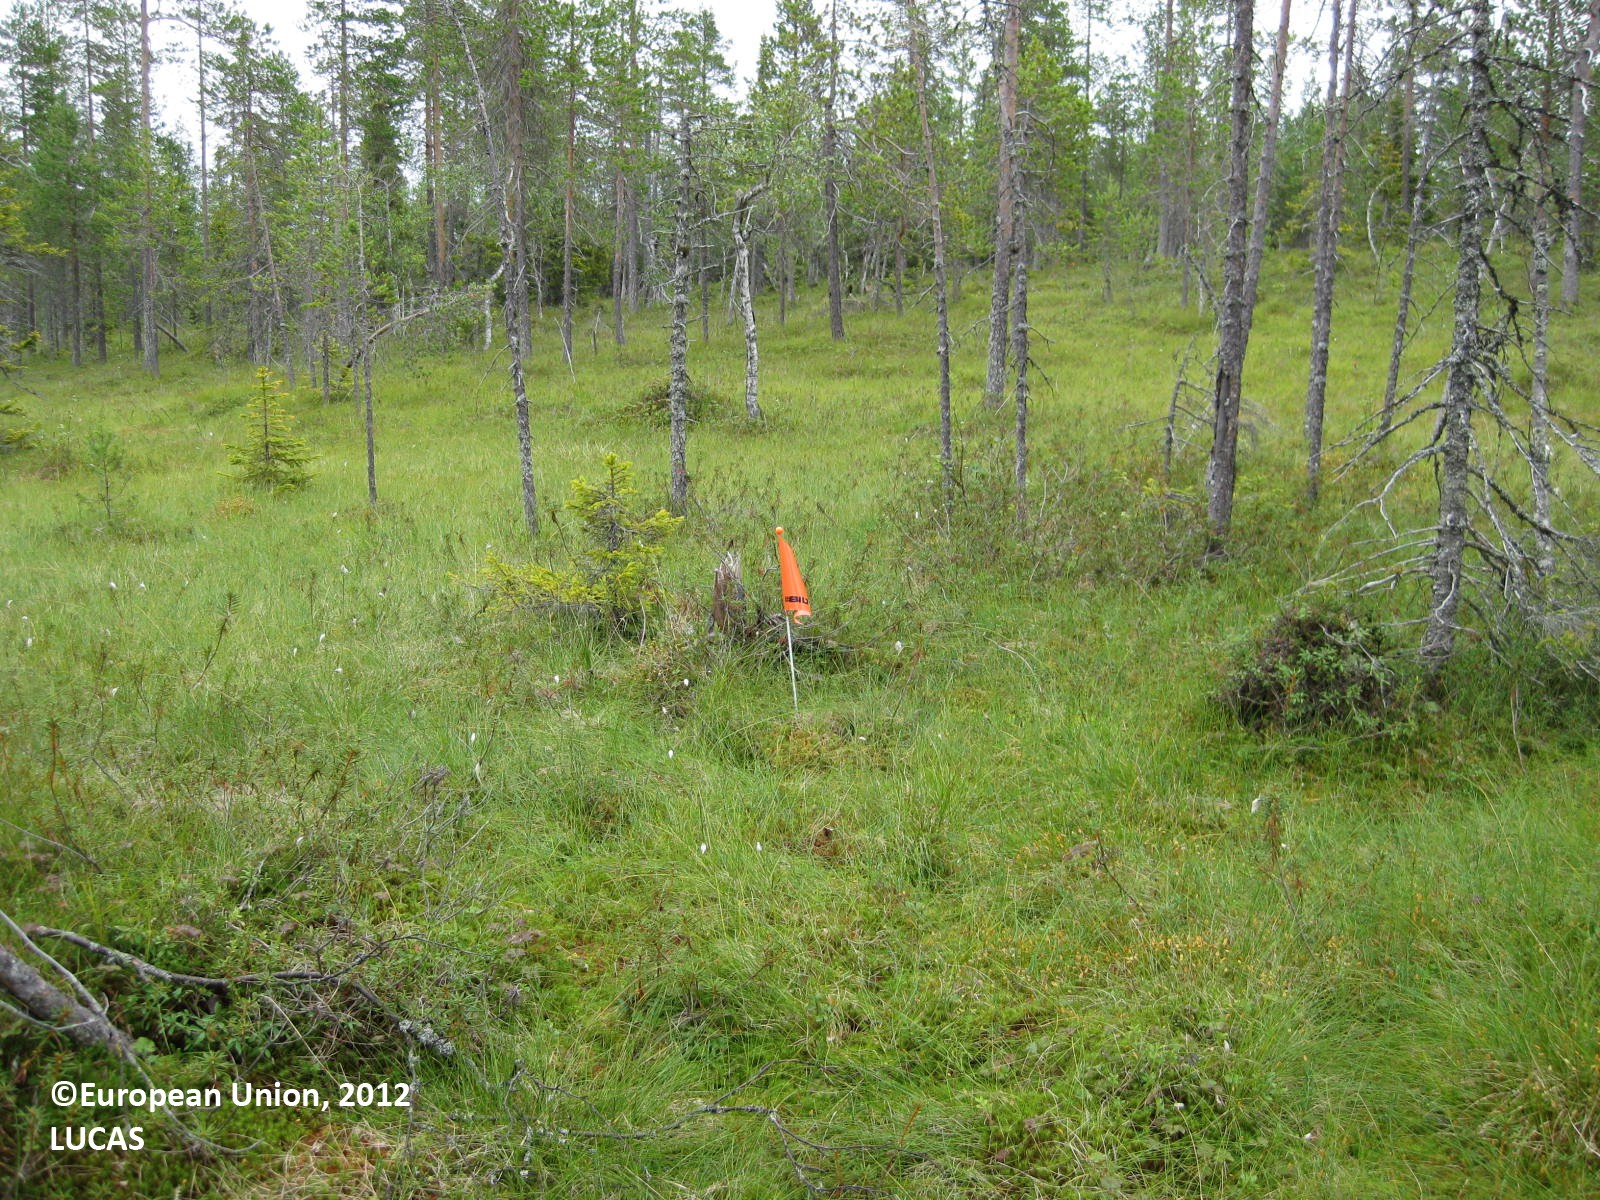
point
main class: Woodland
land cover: Pine dominated coniferous woodland
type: boreal forest
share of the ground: 10 - 25 %
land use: Semi-natural and natural areas not in use
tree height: > 5 m
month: August
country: FI
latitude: 66.0152
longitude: 28.2452
